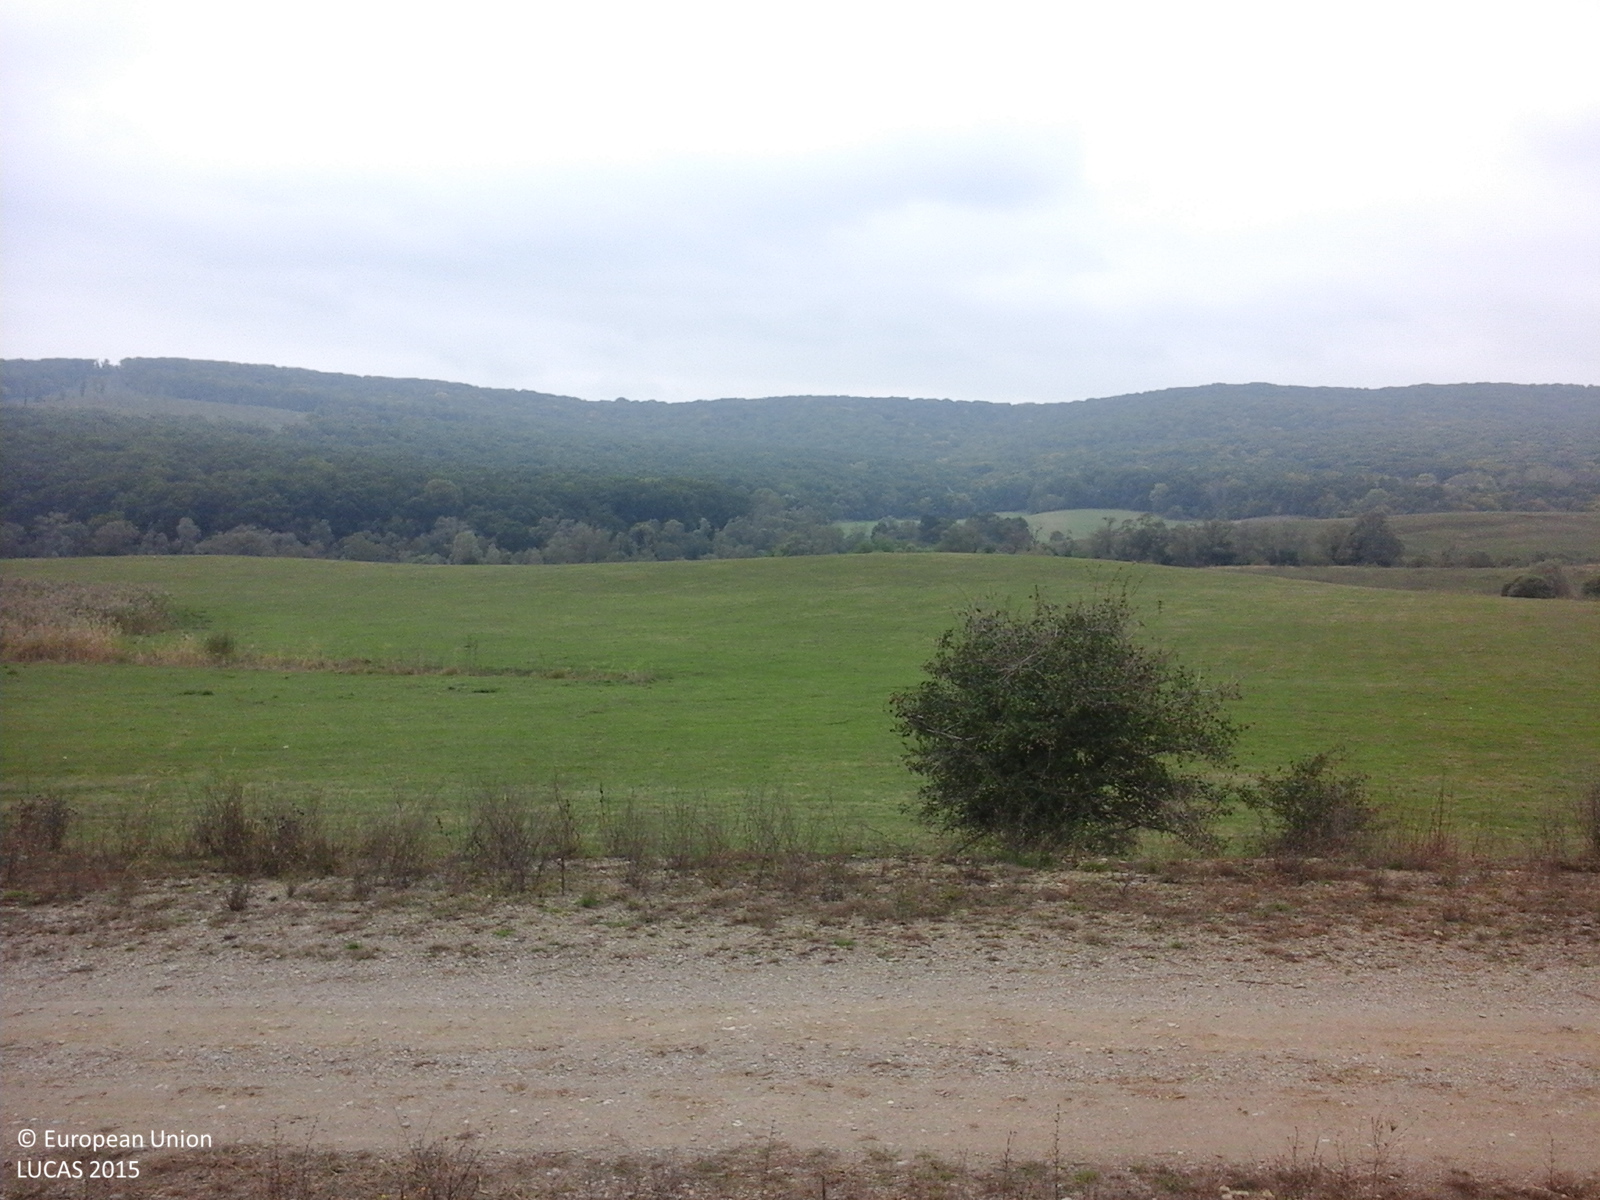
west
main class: Grassland
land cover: Grassland without tree/shrub cover
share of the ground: > 75 %
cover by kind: herbaceous plants 100 %
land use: Agriculture (excluding fallow land and kitchen gardens)
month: October
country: RO
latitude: 45.9492
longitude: 25.0989
